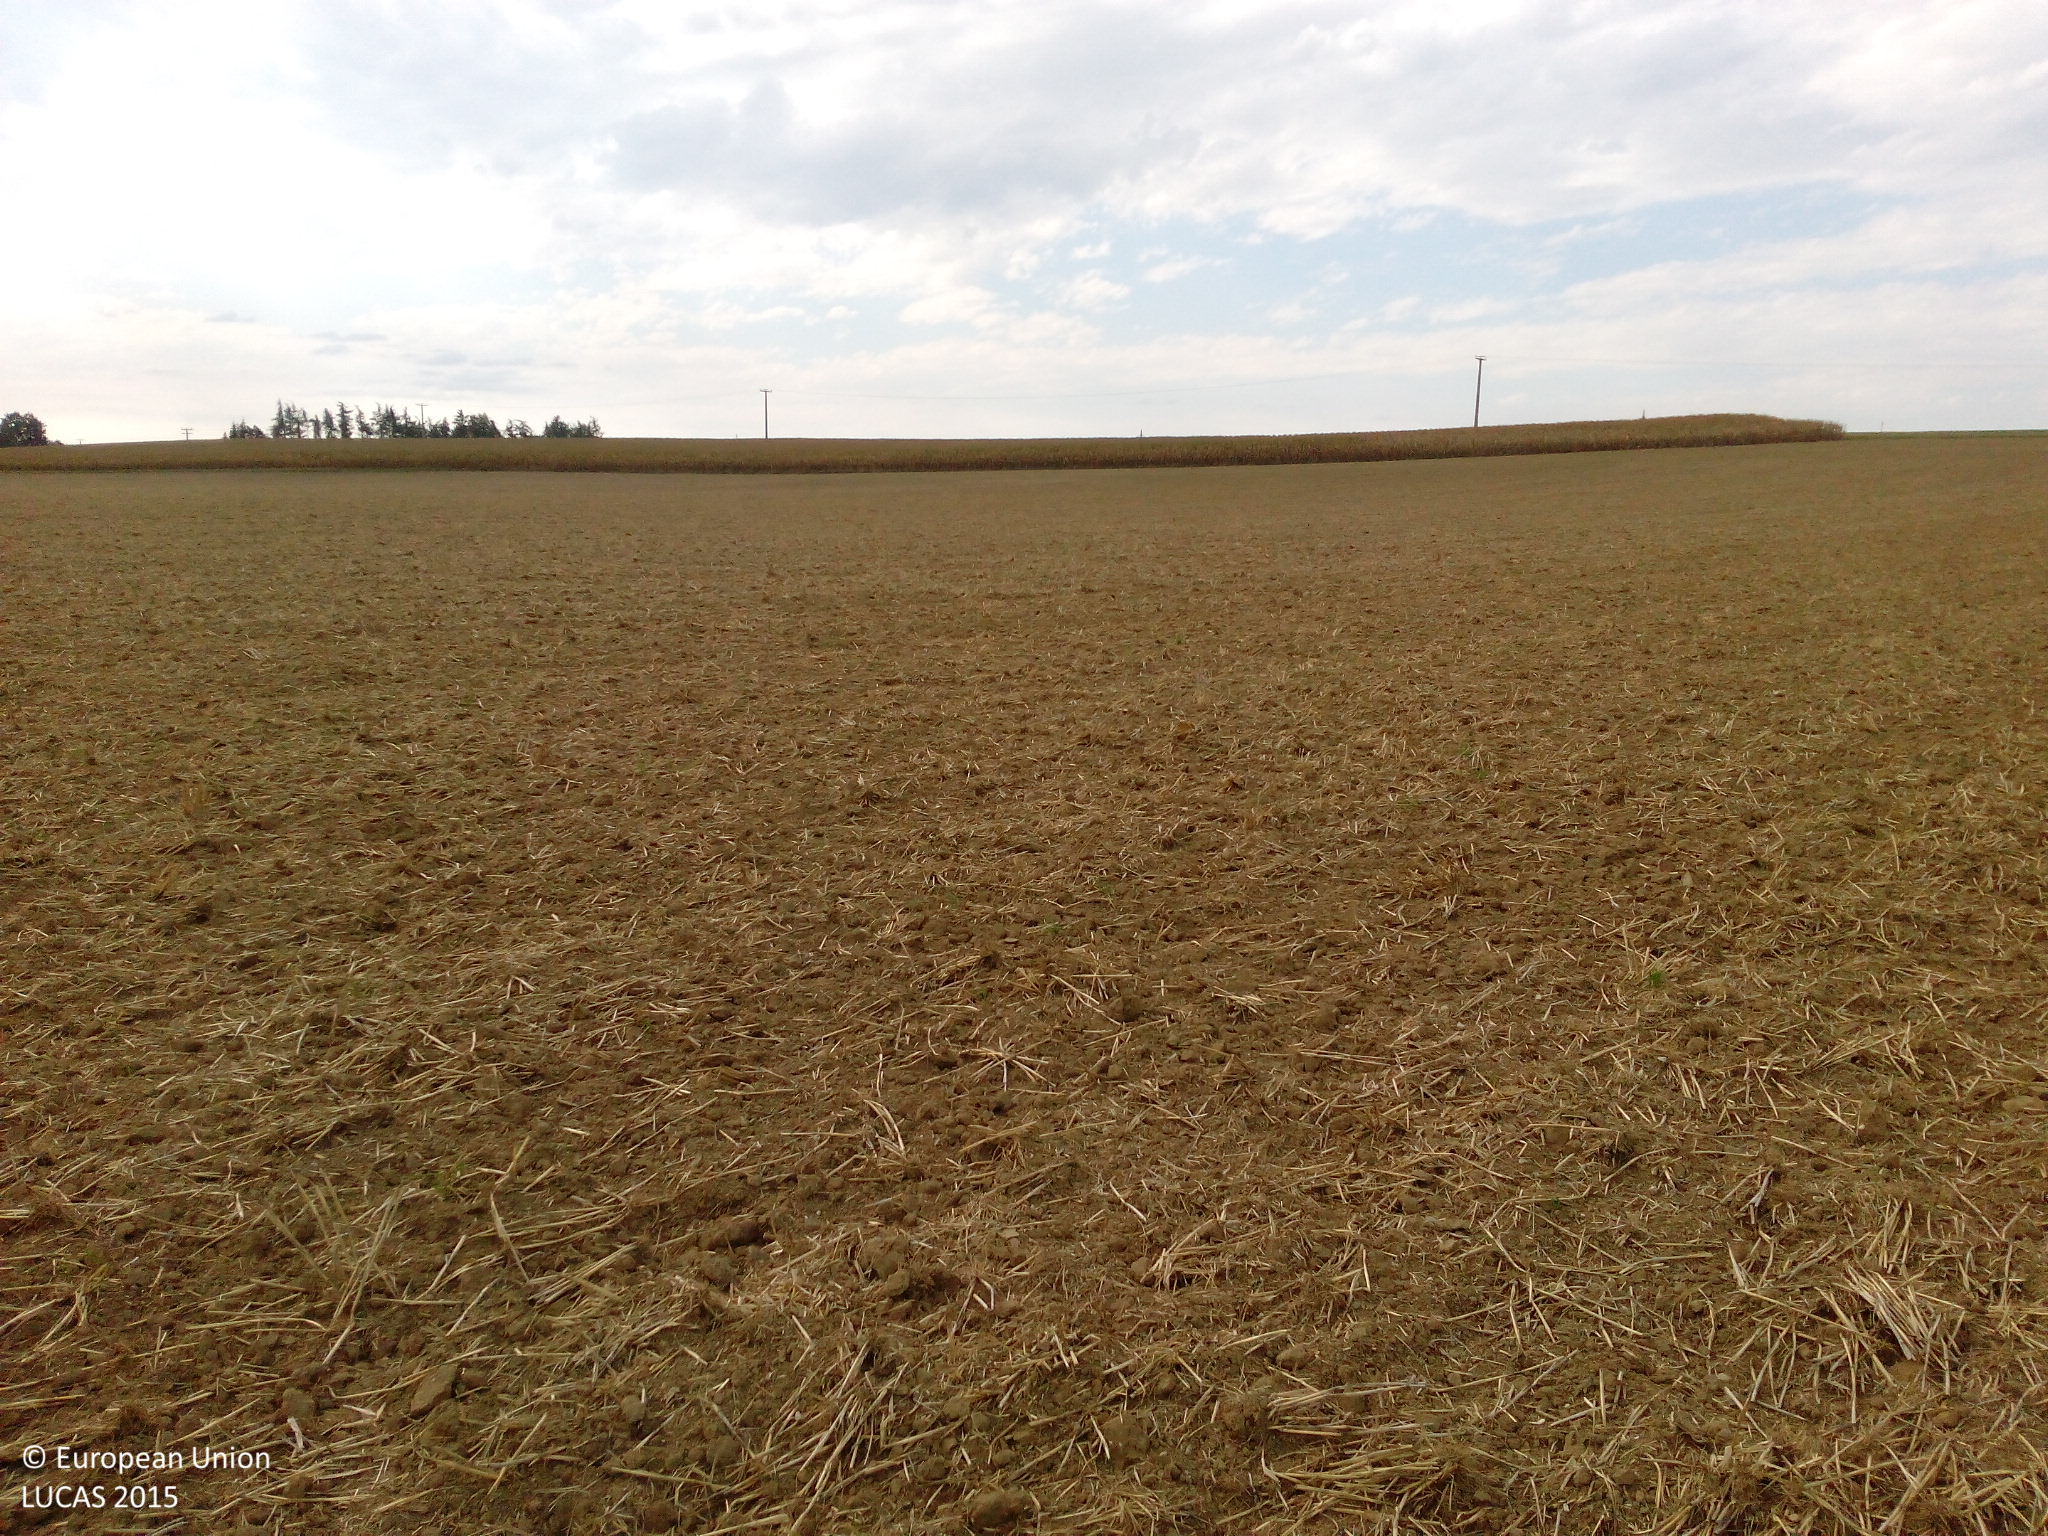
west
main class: Cropland
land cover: Common wheat
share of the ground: 10 - 25 %
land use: Agriculture (excluding fallow land and kitchen gardens)
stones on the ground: < 10 %
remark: Harvested field
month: September
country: DE
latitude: 48.4770
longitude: 11.9066
